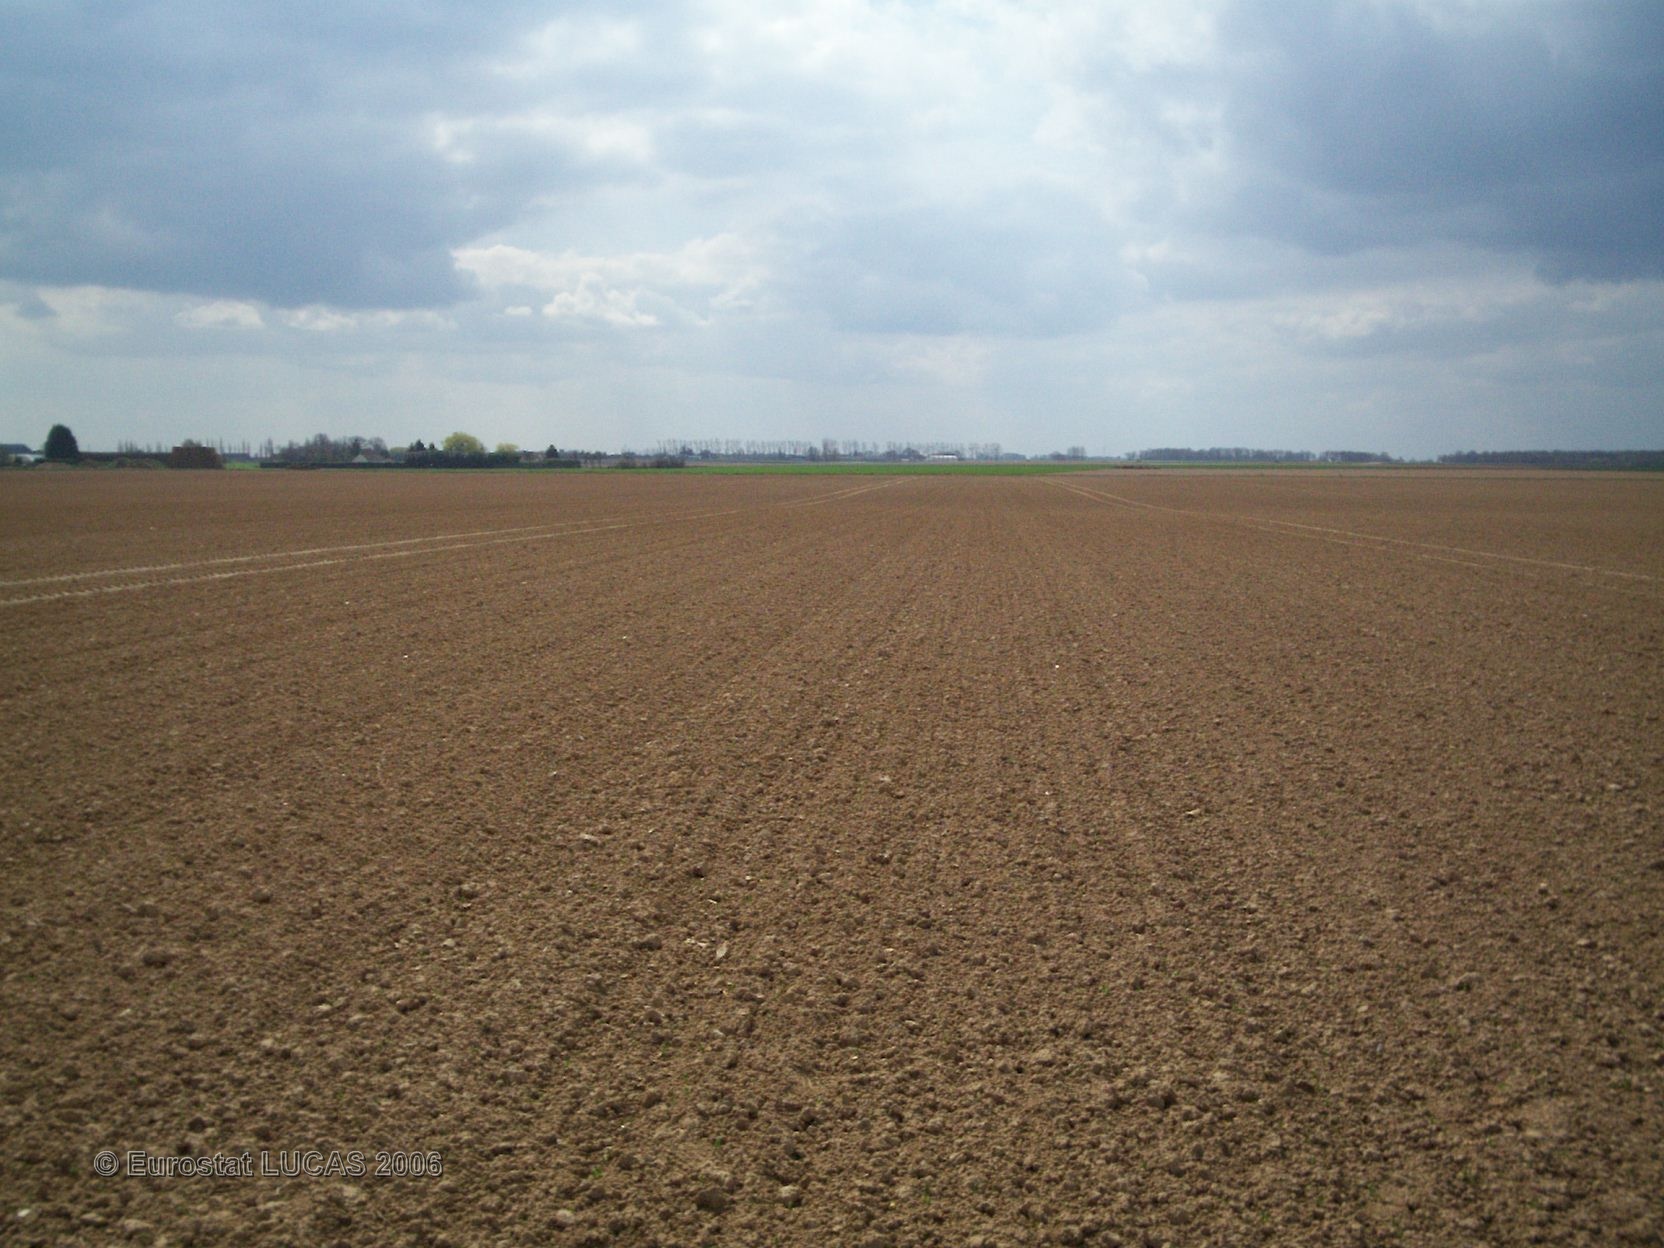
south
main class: Cropland
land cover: Dry pulses
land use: Agriculture (excluding fallow land and kitchen gardens)
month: April
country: FR
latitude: 49.0865
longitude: 1.0097
